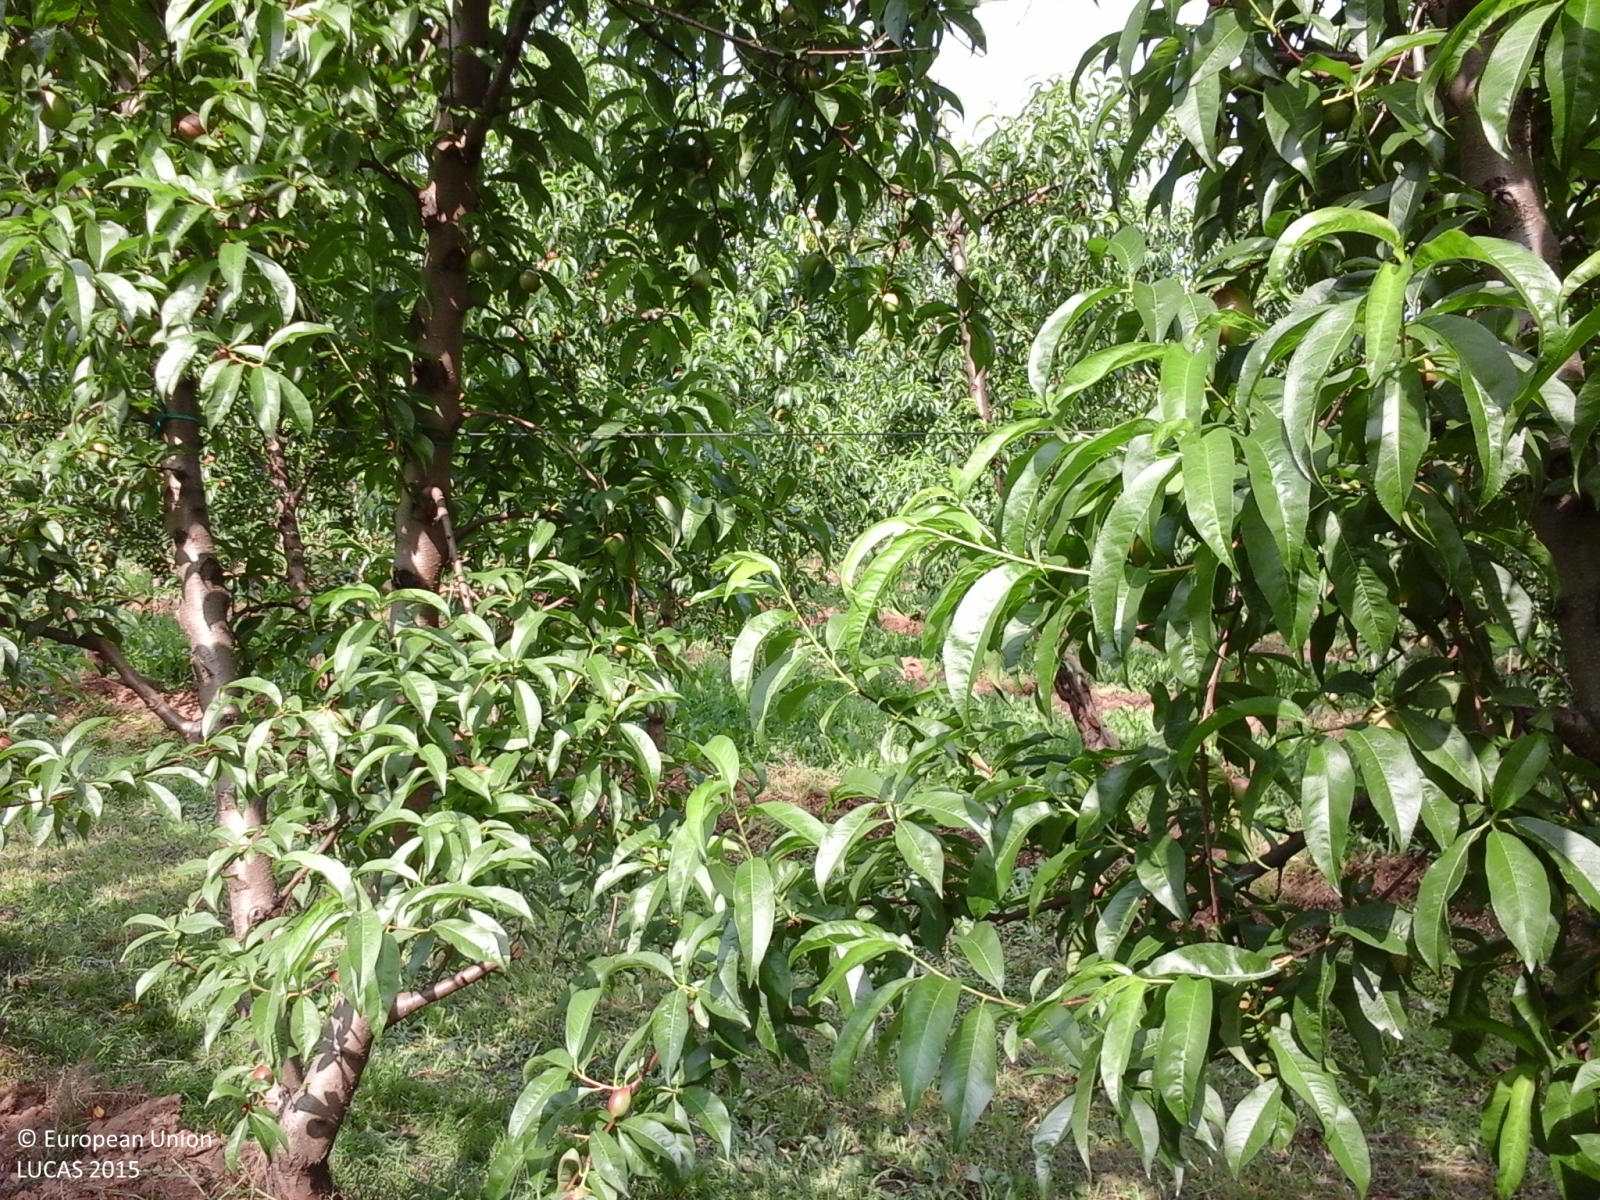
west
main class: Cropland
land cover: Other fruit trees and berries
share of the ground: 50 - 75 %
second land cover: Grassland without tree/shrub cover
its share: 50 - 75 %
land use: Agriculture (excluding fallow land and kitchen gardens)
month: June
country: IT
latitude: 44.4114
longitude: 7.5312
